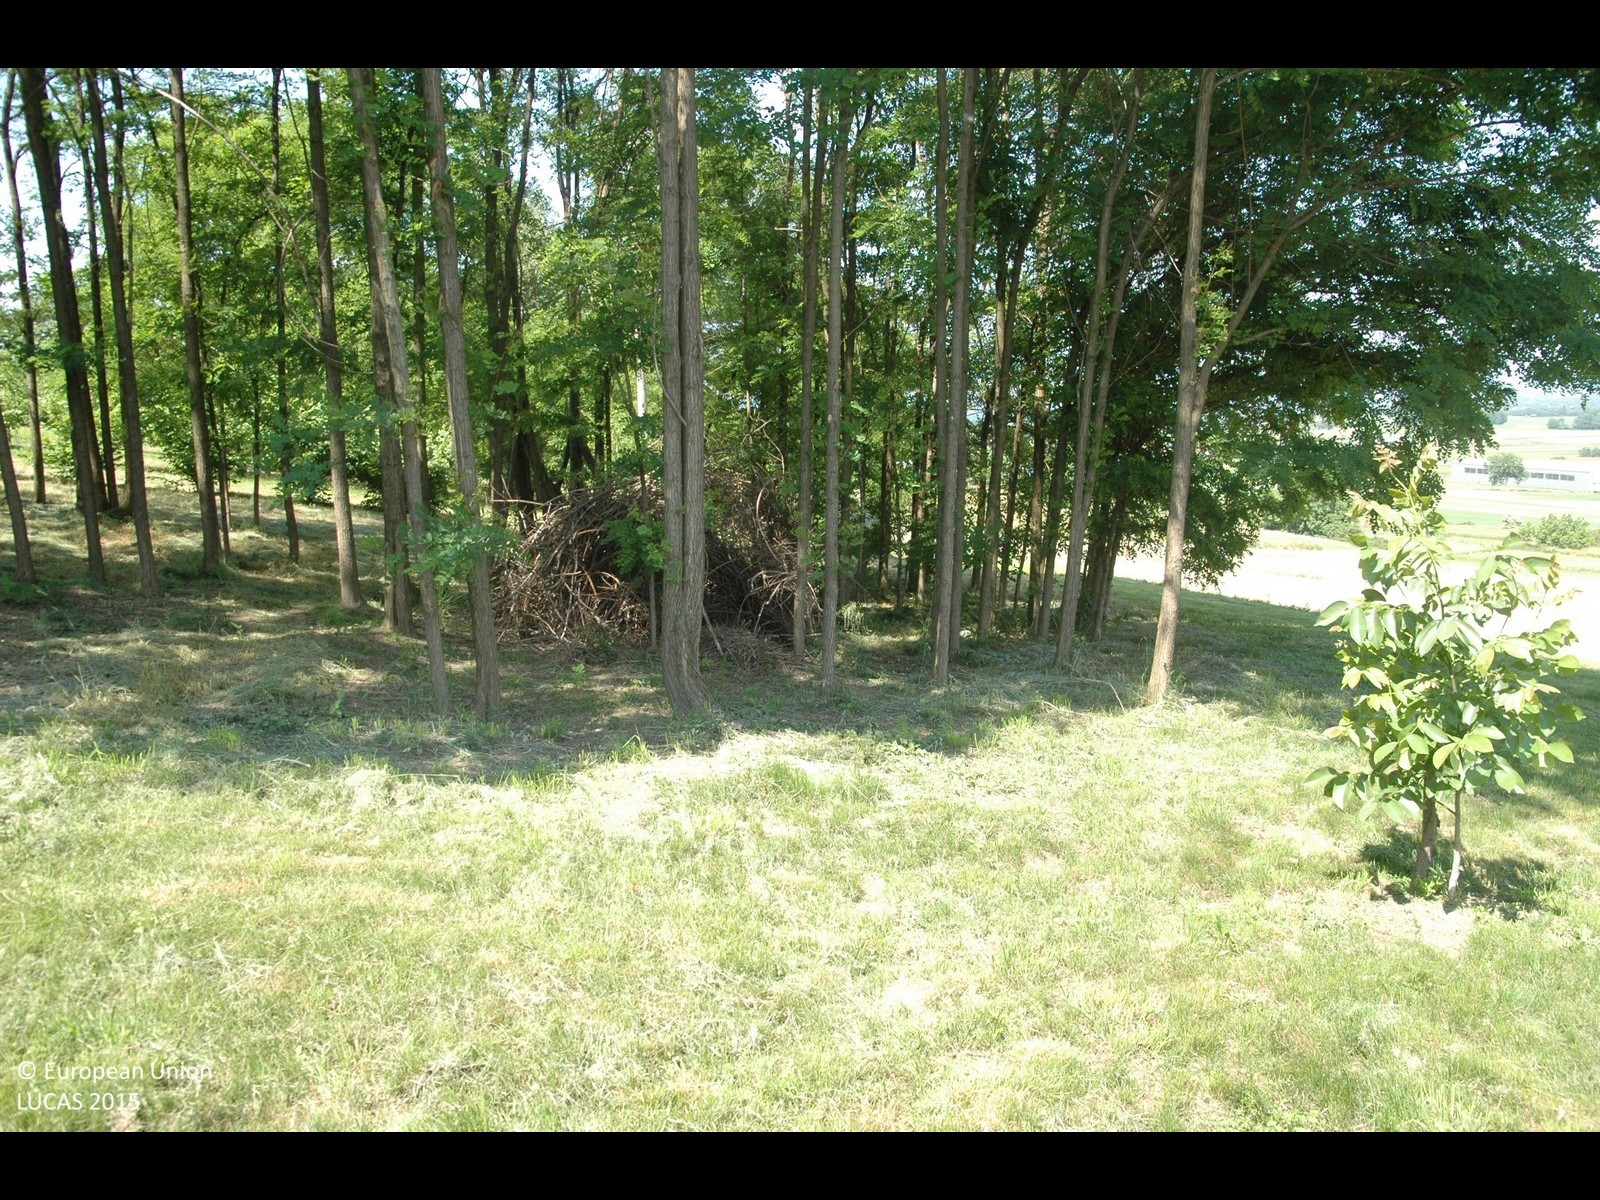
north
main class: Cropland
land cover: Nuts trees
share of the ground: 10 - 25 %
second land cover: Grassland without tree/shrub cover
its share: 50 - 75 %
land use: Agriculture (excluding fallow land and kitchen gardens)
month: May
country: HR
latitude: 46.4849
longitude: 16.3969
